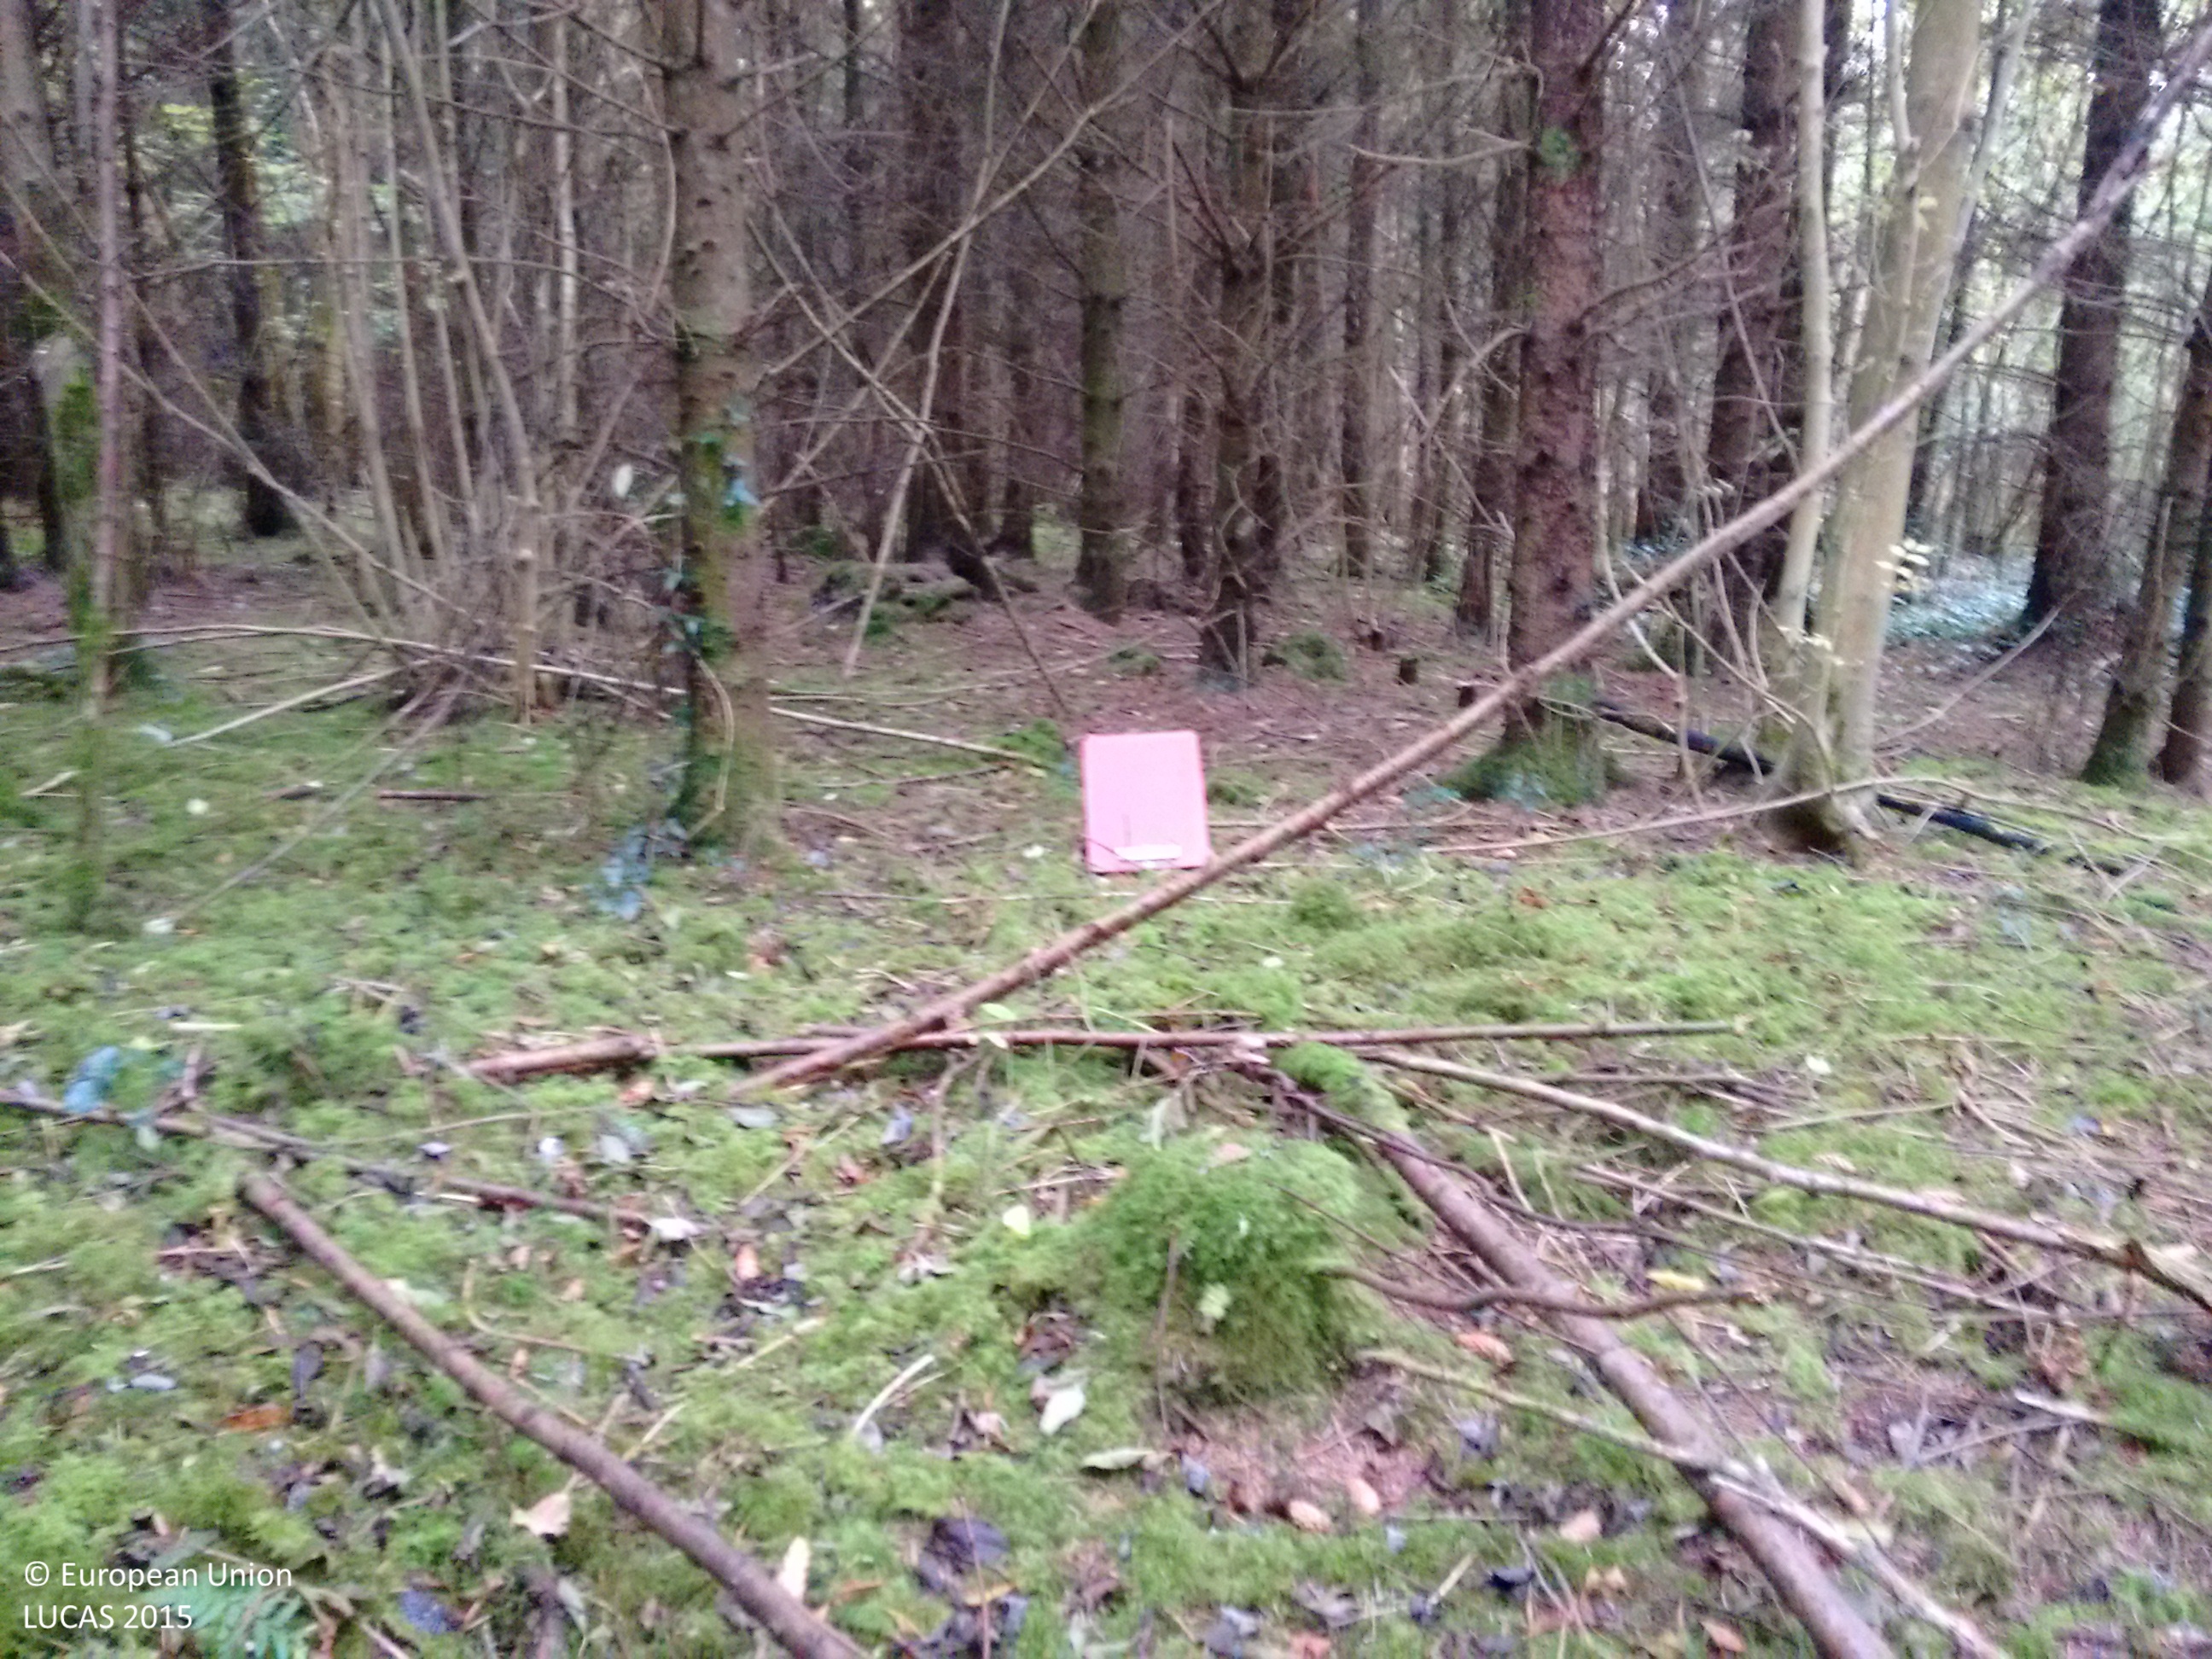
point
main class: Woodland
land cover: Spruce dominated mixed woodland
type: exotic forest
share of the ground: > 75 %
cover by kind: coniferous forest trees 75 %, broadleaved forest trees 25 %
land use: Forestry
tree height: > 5 m
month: October
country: IE
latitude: 52.8427
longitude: -7.4228
